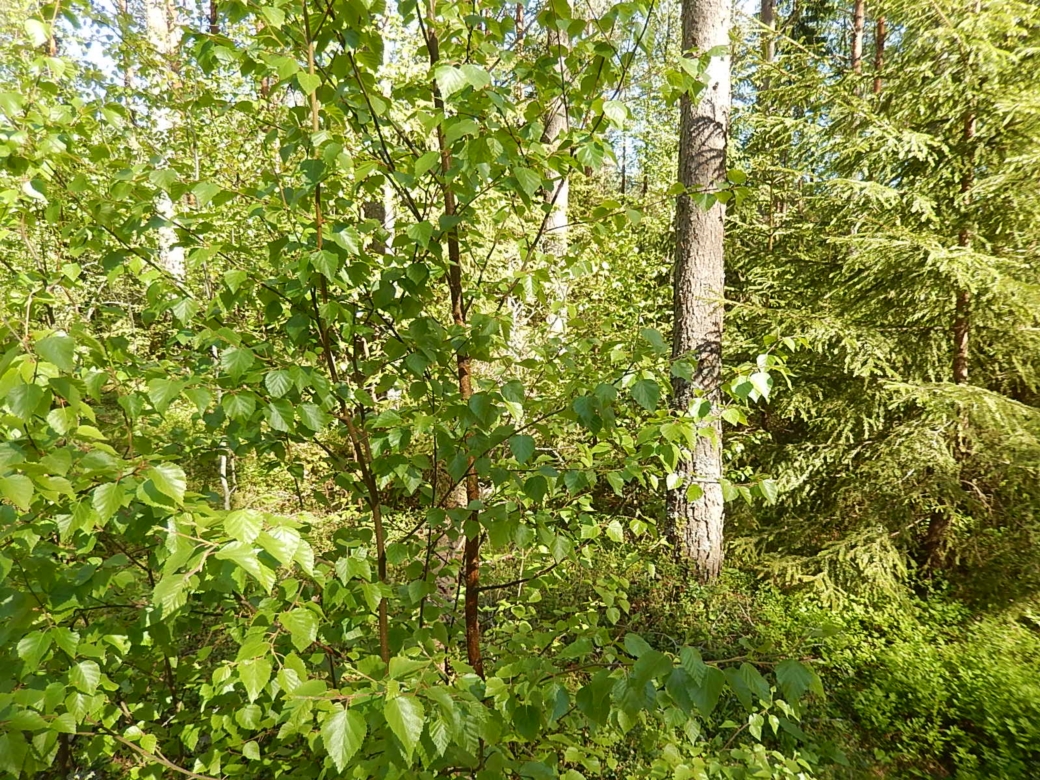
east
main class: Woodland
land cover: Pine dominated coniferous woodland
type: boreal forest
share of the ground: > 75 %
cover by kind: coniferous forest trees 75 %, herbaceous plants 15 %, broadleaved forest trees 10 %
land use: Forestry
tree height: > 5 m
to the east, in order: Pine dominated coniferous woodland; Pine dominated mixed woodland; Ditches and canals; Pine dominated mixed woodland; Ditches and canals; Broadleaved woodland
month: June
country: FI
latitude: 61.9745
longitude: 21.4359
